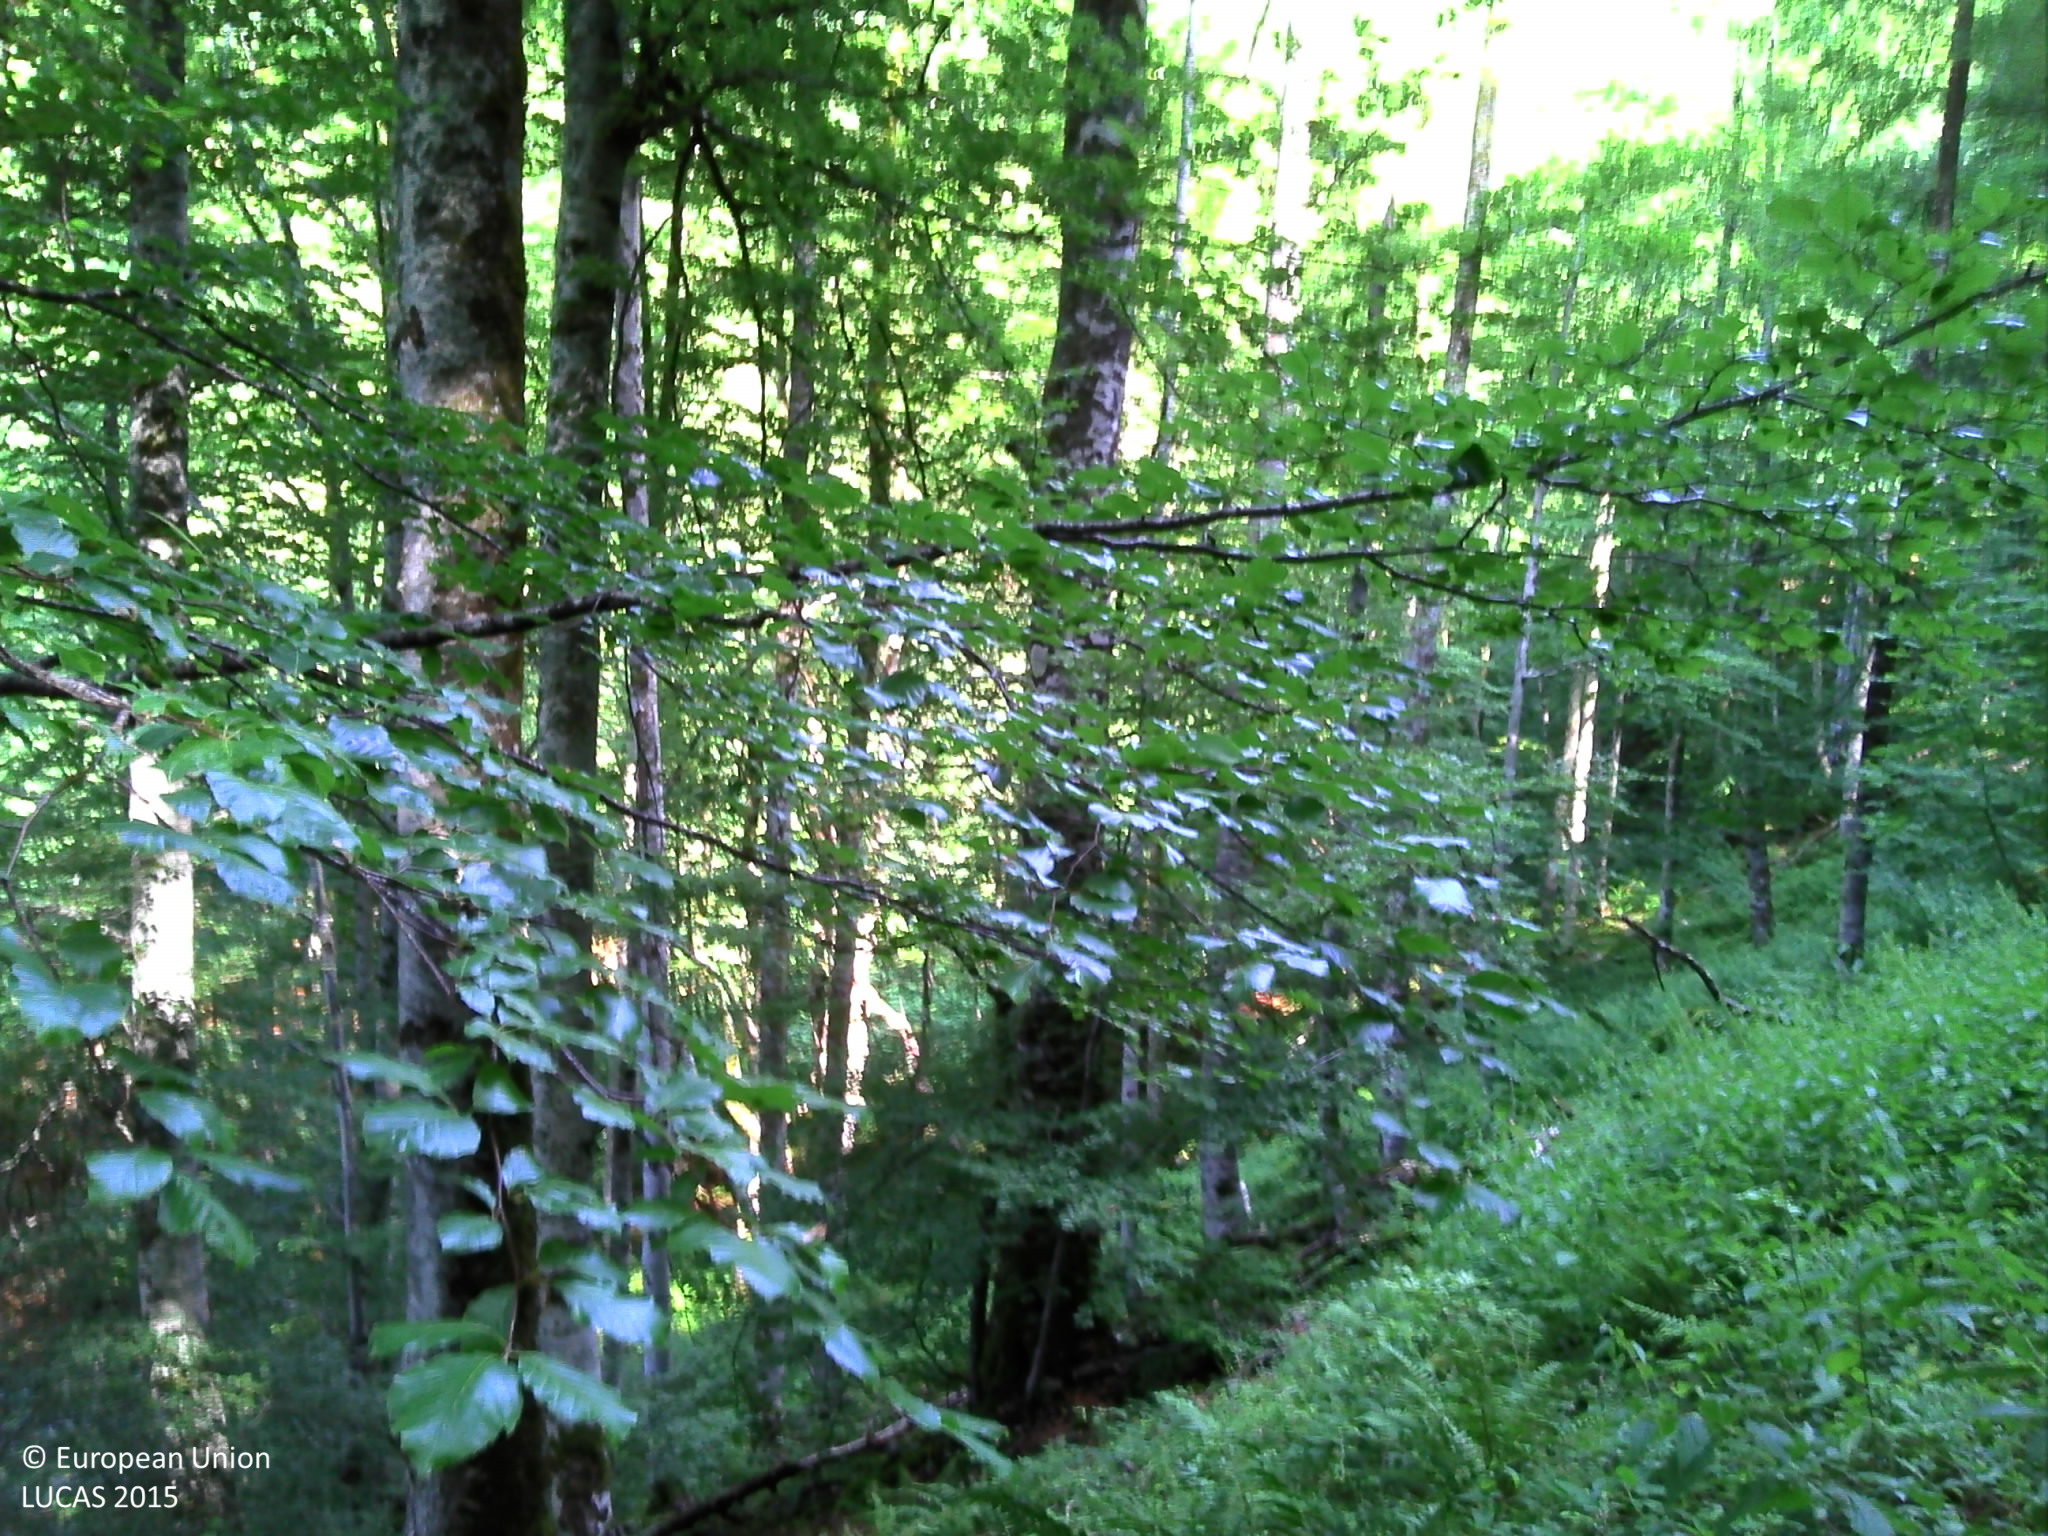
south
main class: Woodland
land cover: Broadleaved woodland
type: beech forest
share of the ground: > 75 %
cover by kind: broadleaved forest trees 50 %, herbaceous plants 50 %
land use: Forestry
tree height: > 5 m
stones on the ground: > 50 %
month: July
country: FR
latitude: 42.8592
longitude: 1.0832
